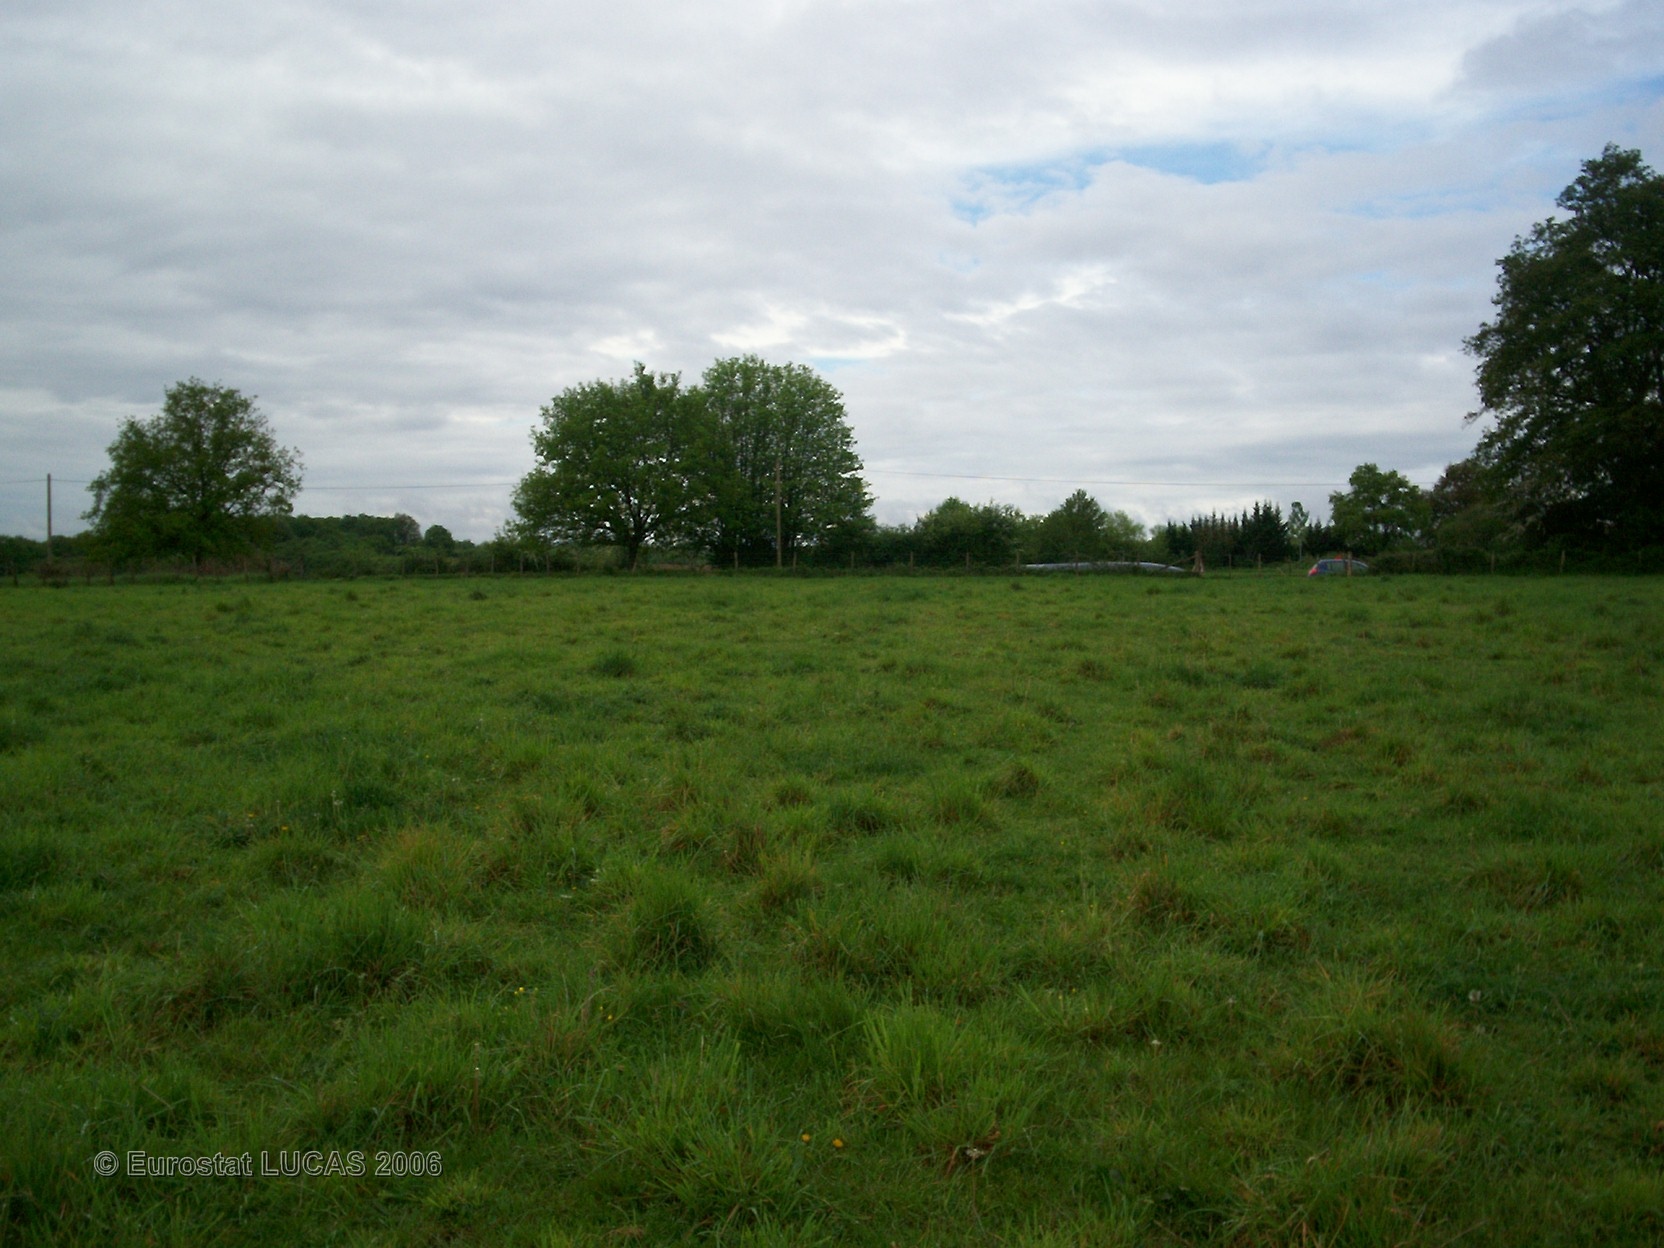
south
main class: Grassland
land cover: Grassland without tree/shrub cover
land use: Agriculture (excluding fallow land and kitchen gardens)
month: May
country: FR
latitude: 46.0485
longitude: 0.4334
